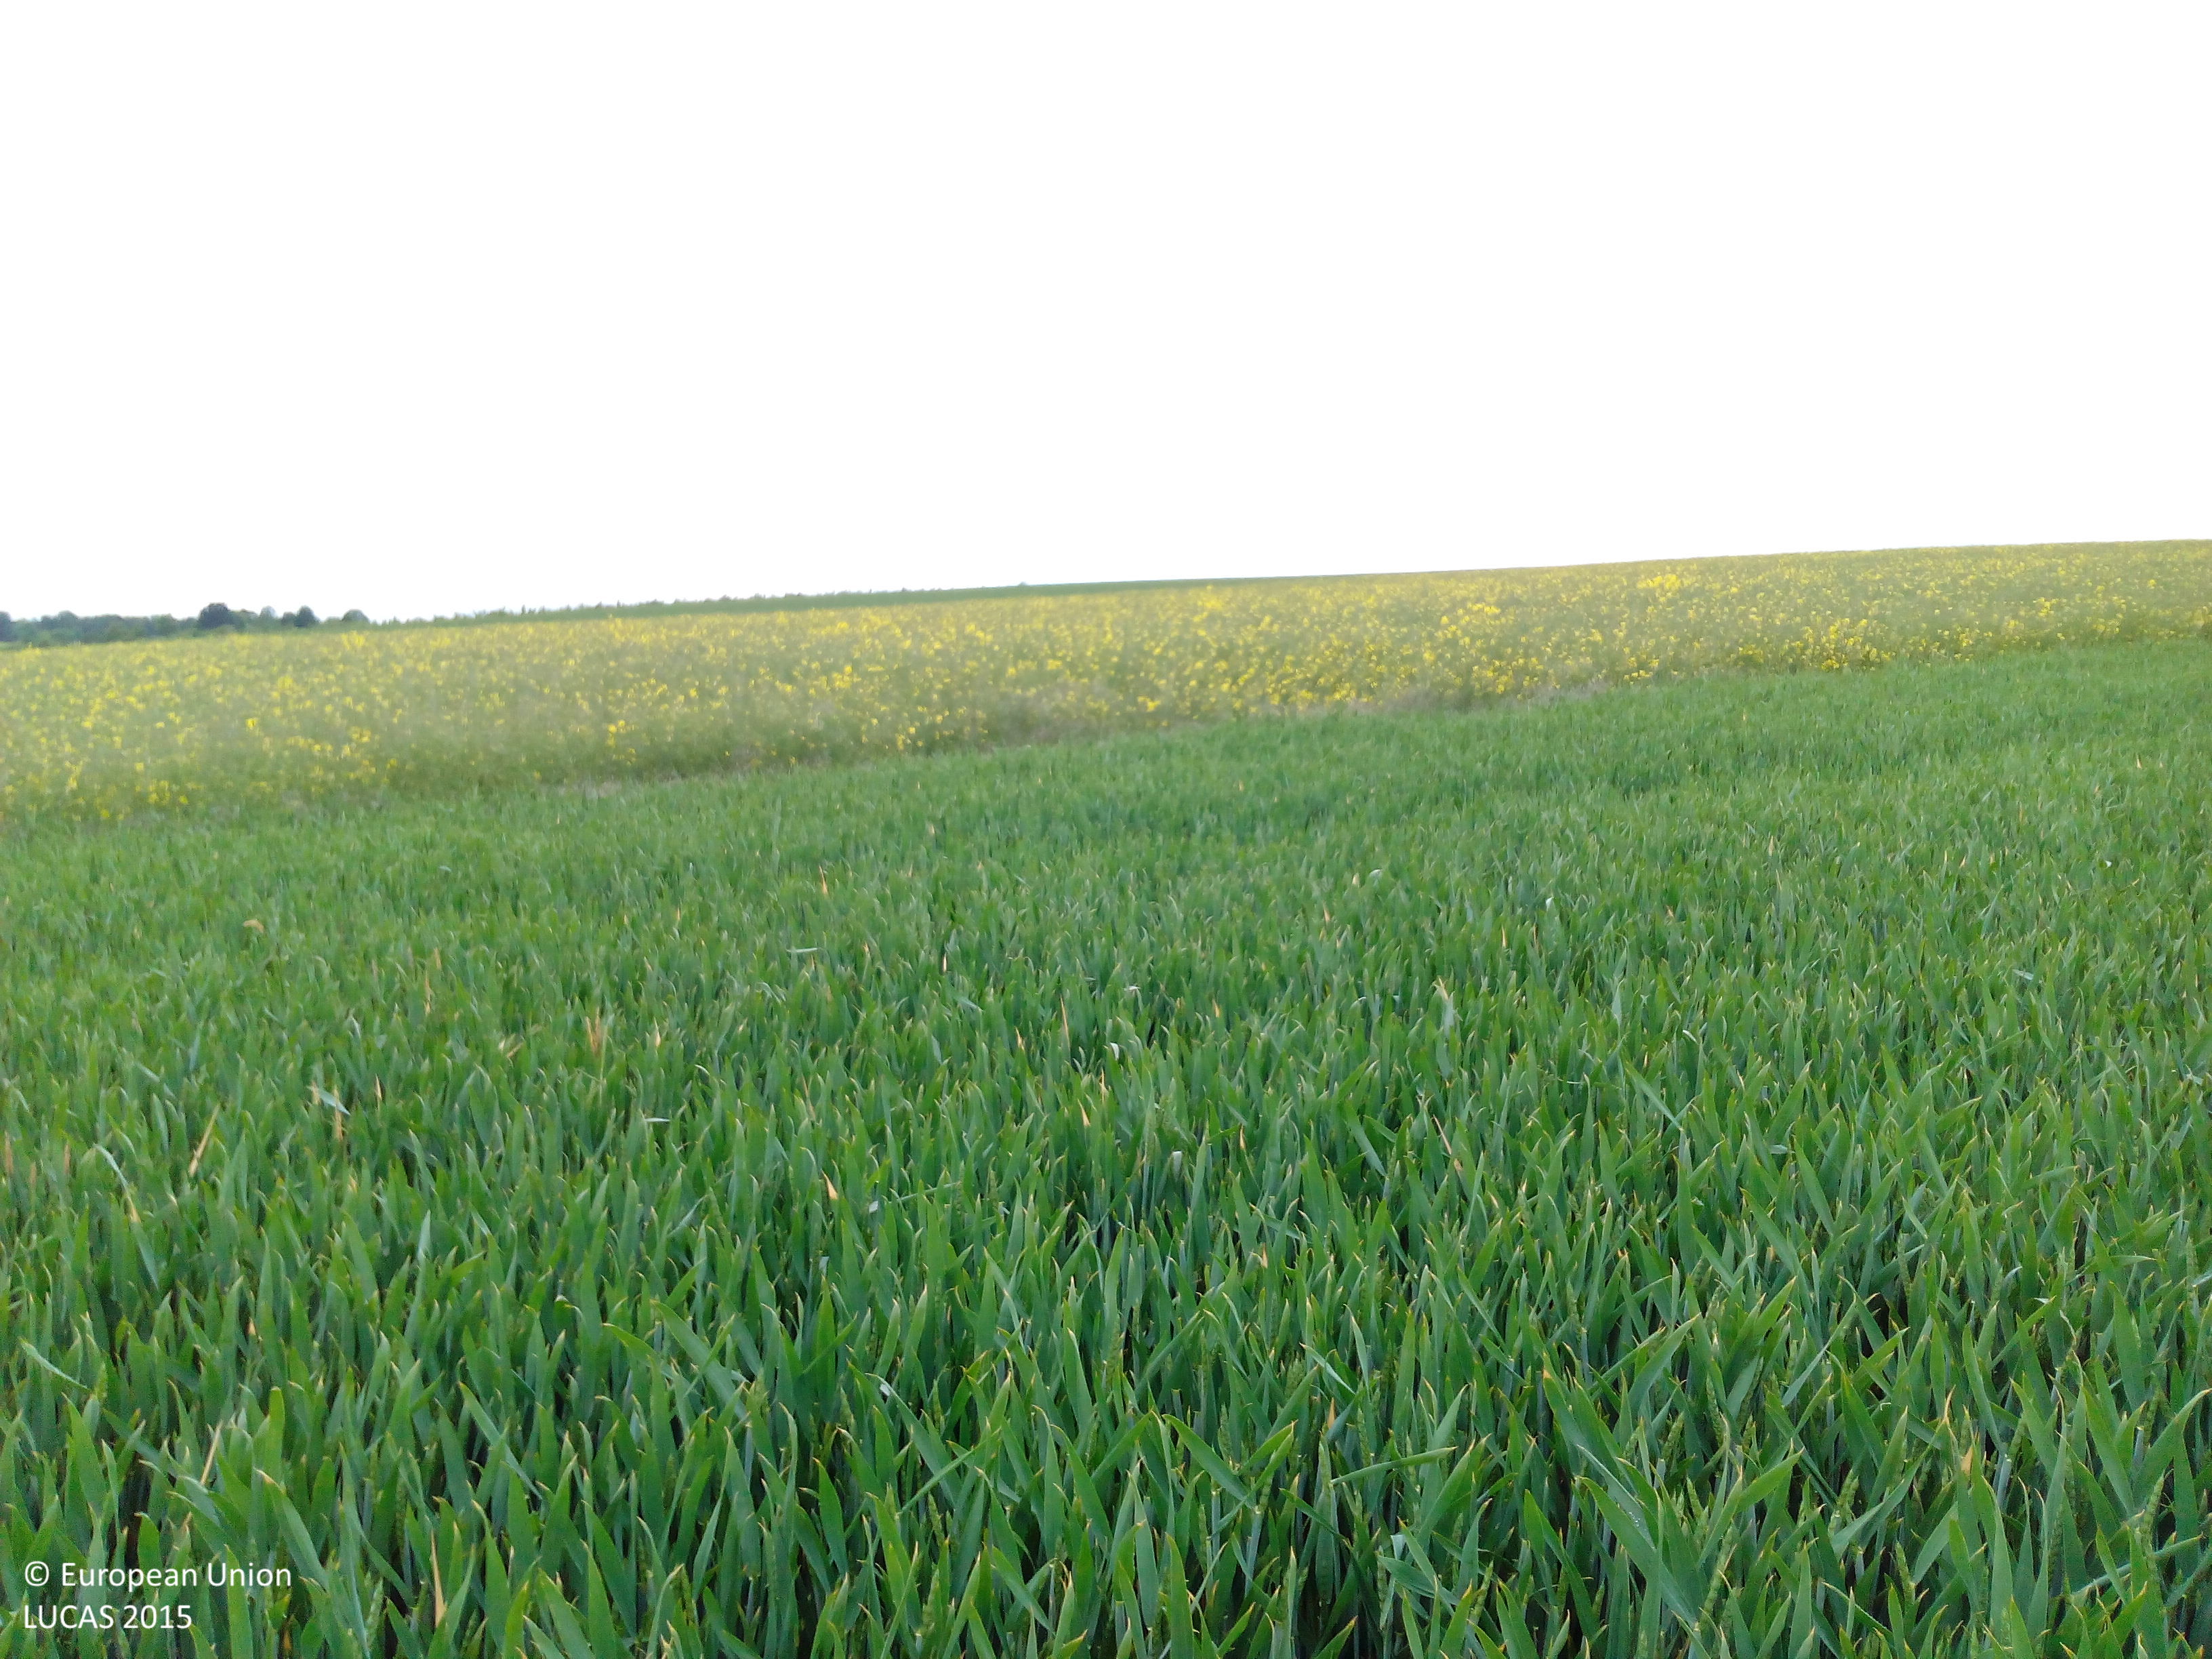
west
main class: Cropland
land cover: Rape and turnip rape
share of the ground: > 75 %
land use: Agriculture (excluding fallow land and kitchen gardens)
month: May
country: DE
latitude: 52.0000
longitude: 9.9272
